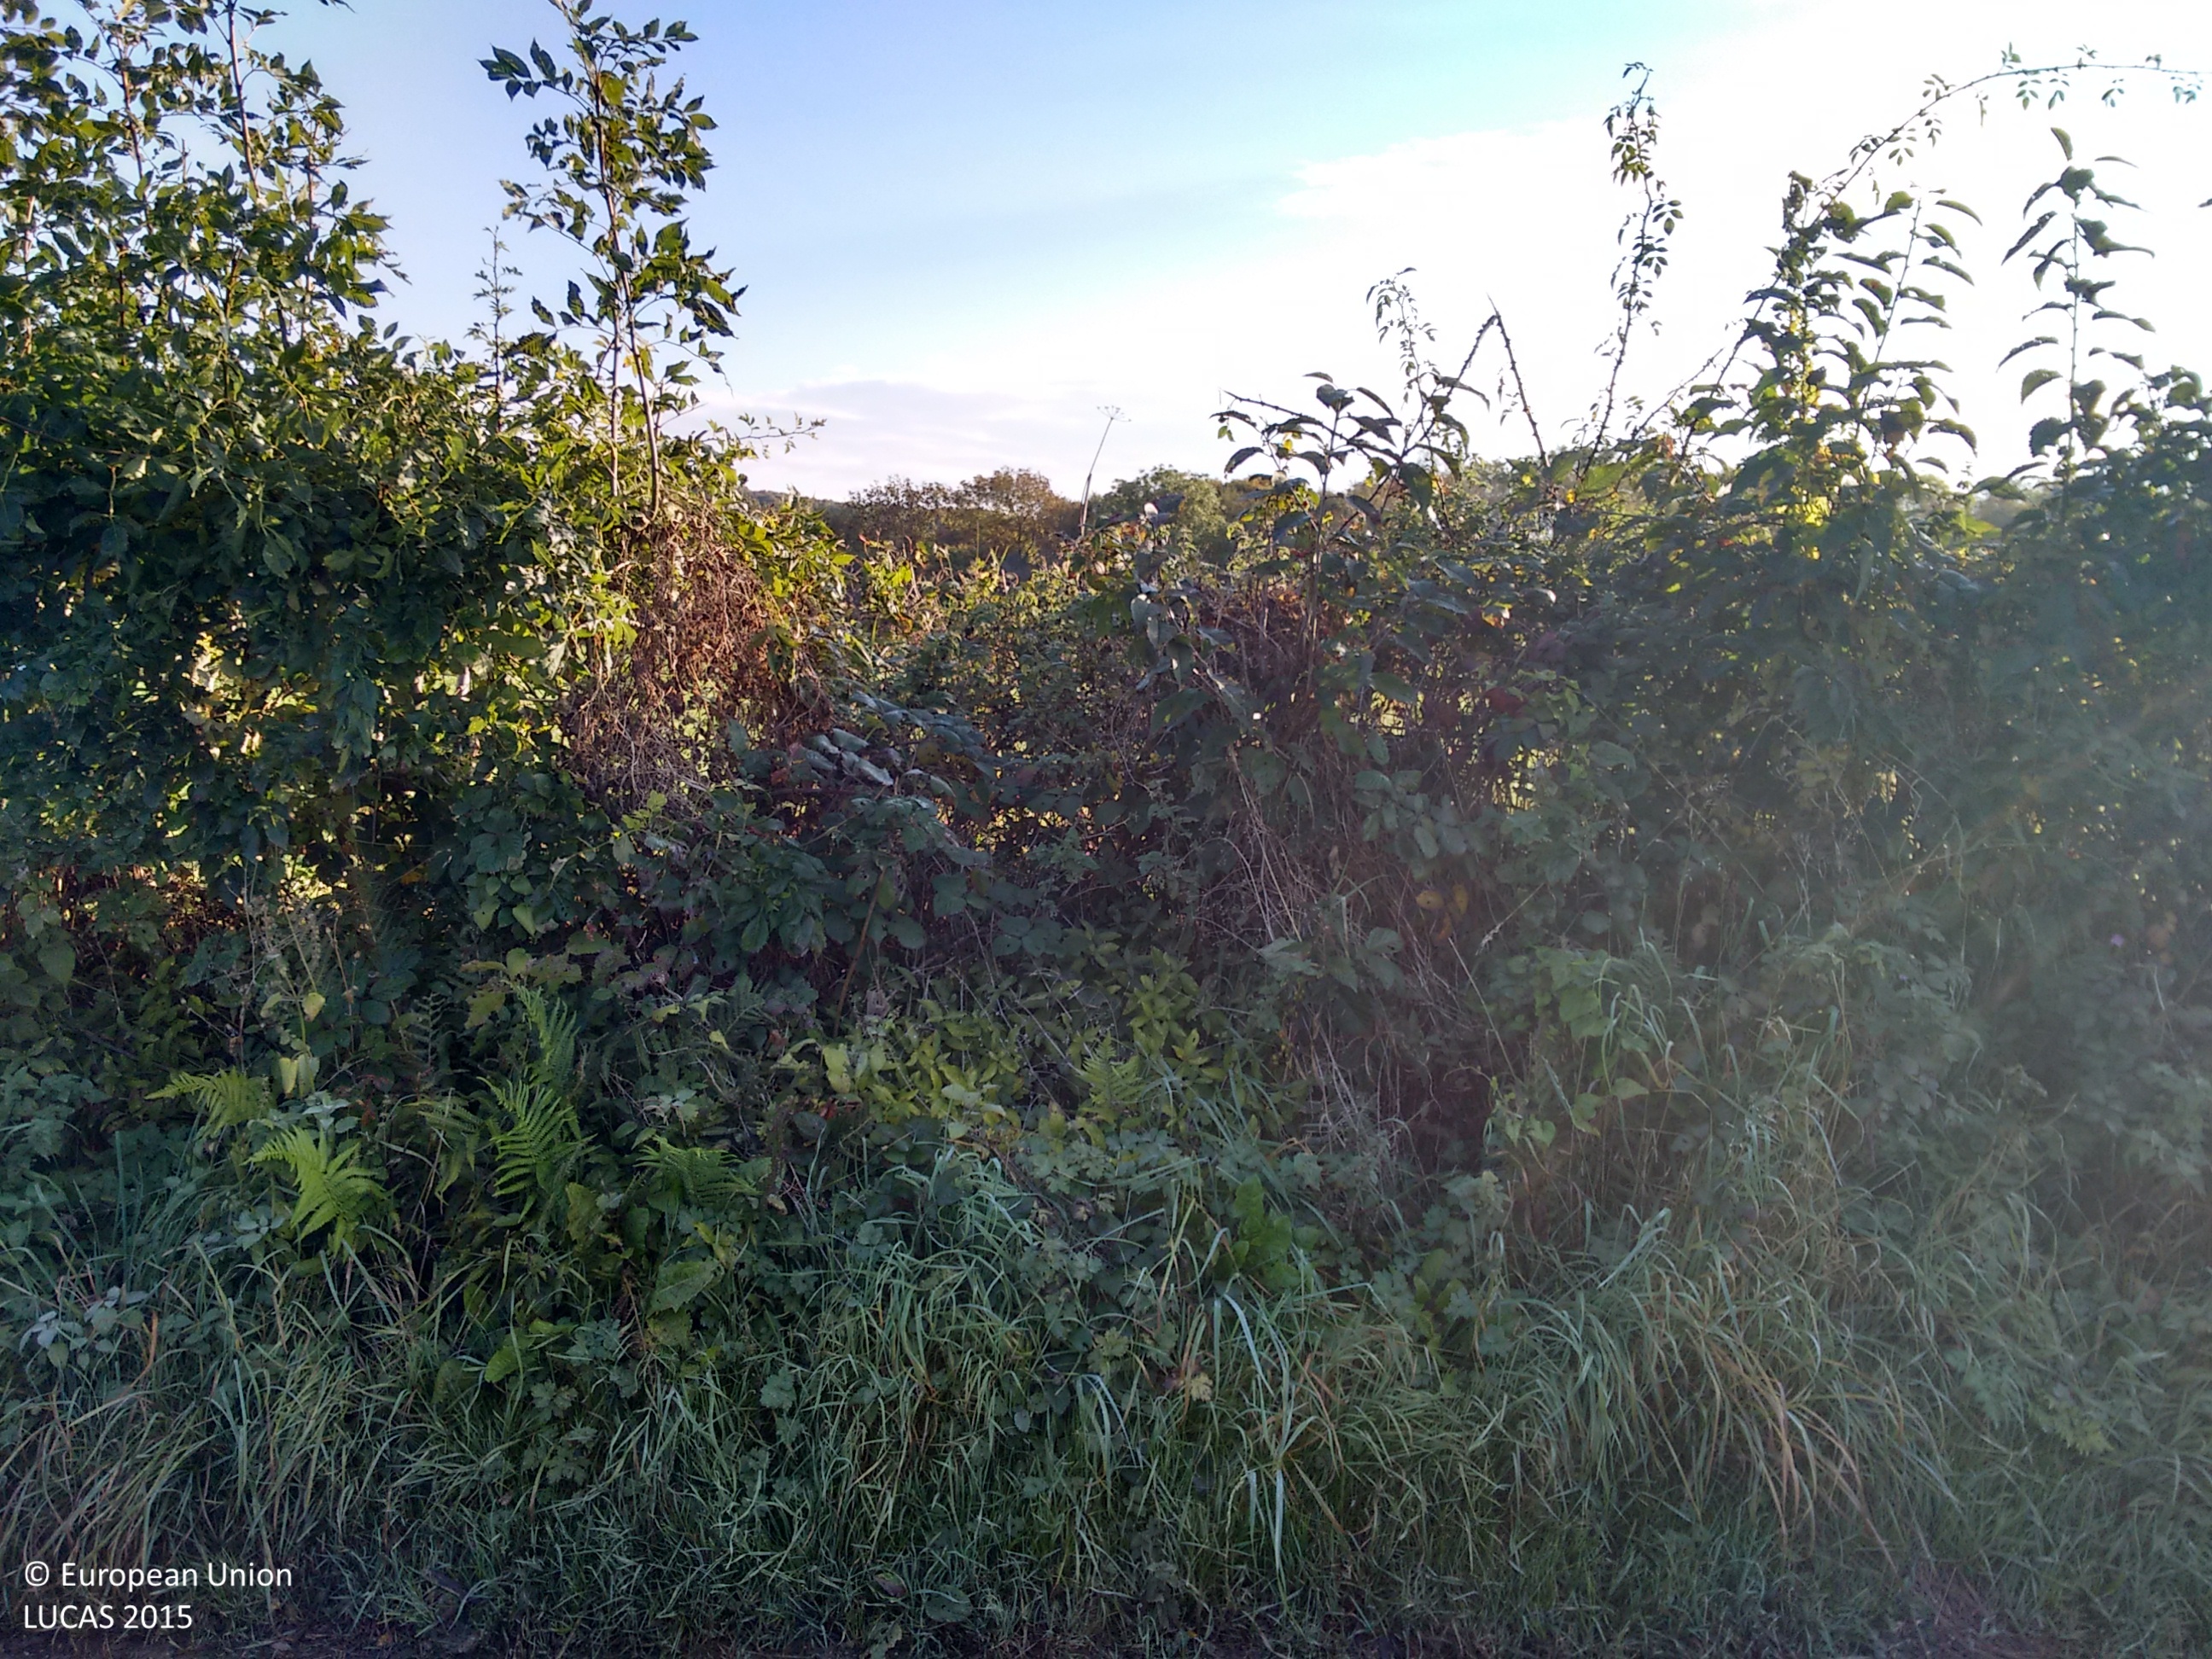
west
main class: Grassland
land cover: Grassland without tree/shrub cover
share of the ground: > 75 %
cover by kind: herbaceous plants 100 %
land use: Agriculture (excluding fallow land and kitchen gardens)
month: October
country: GB
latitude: 54.2037
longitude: -3.0592
